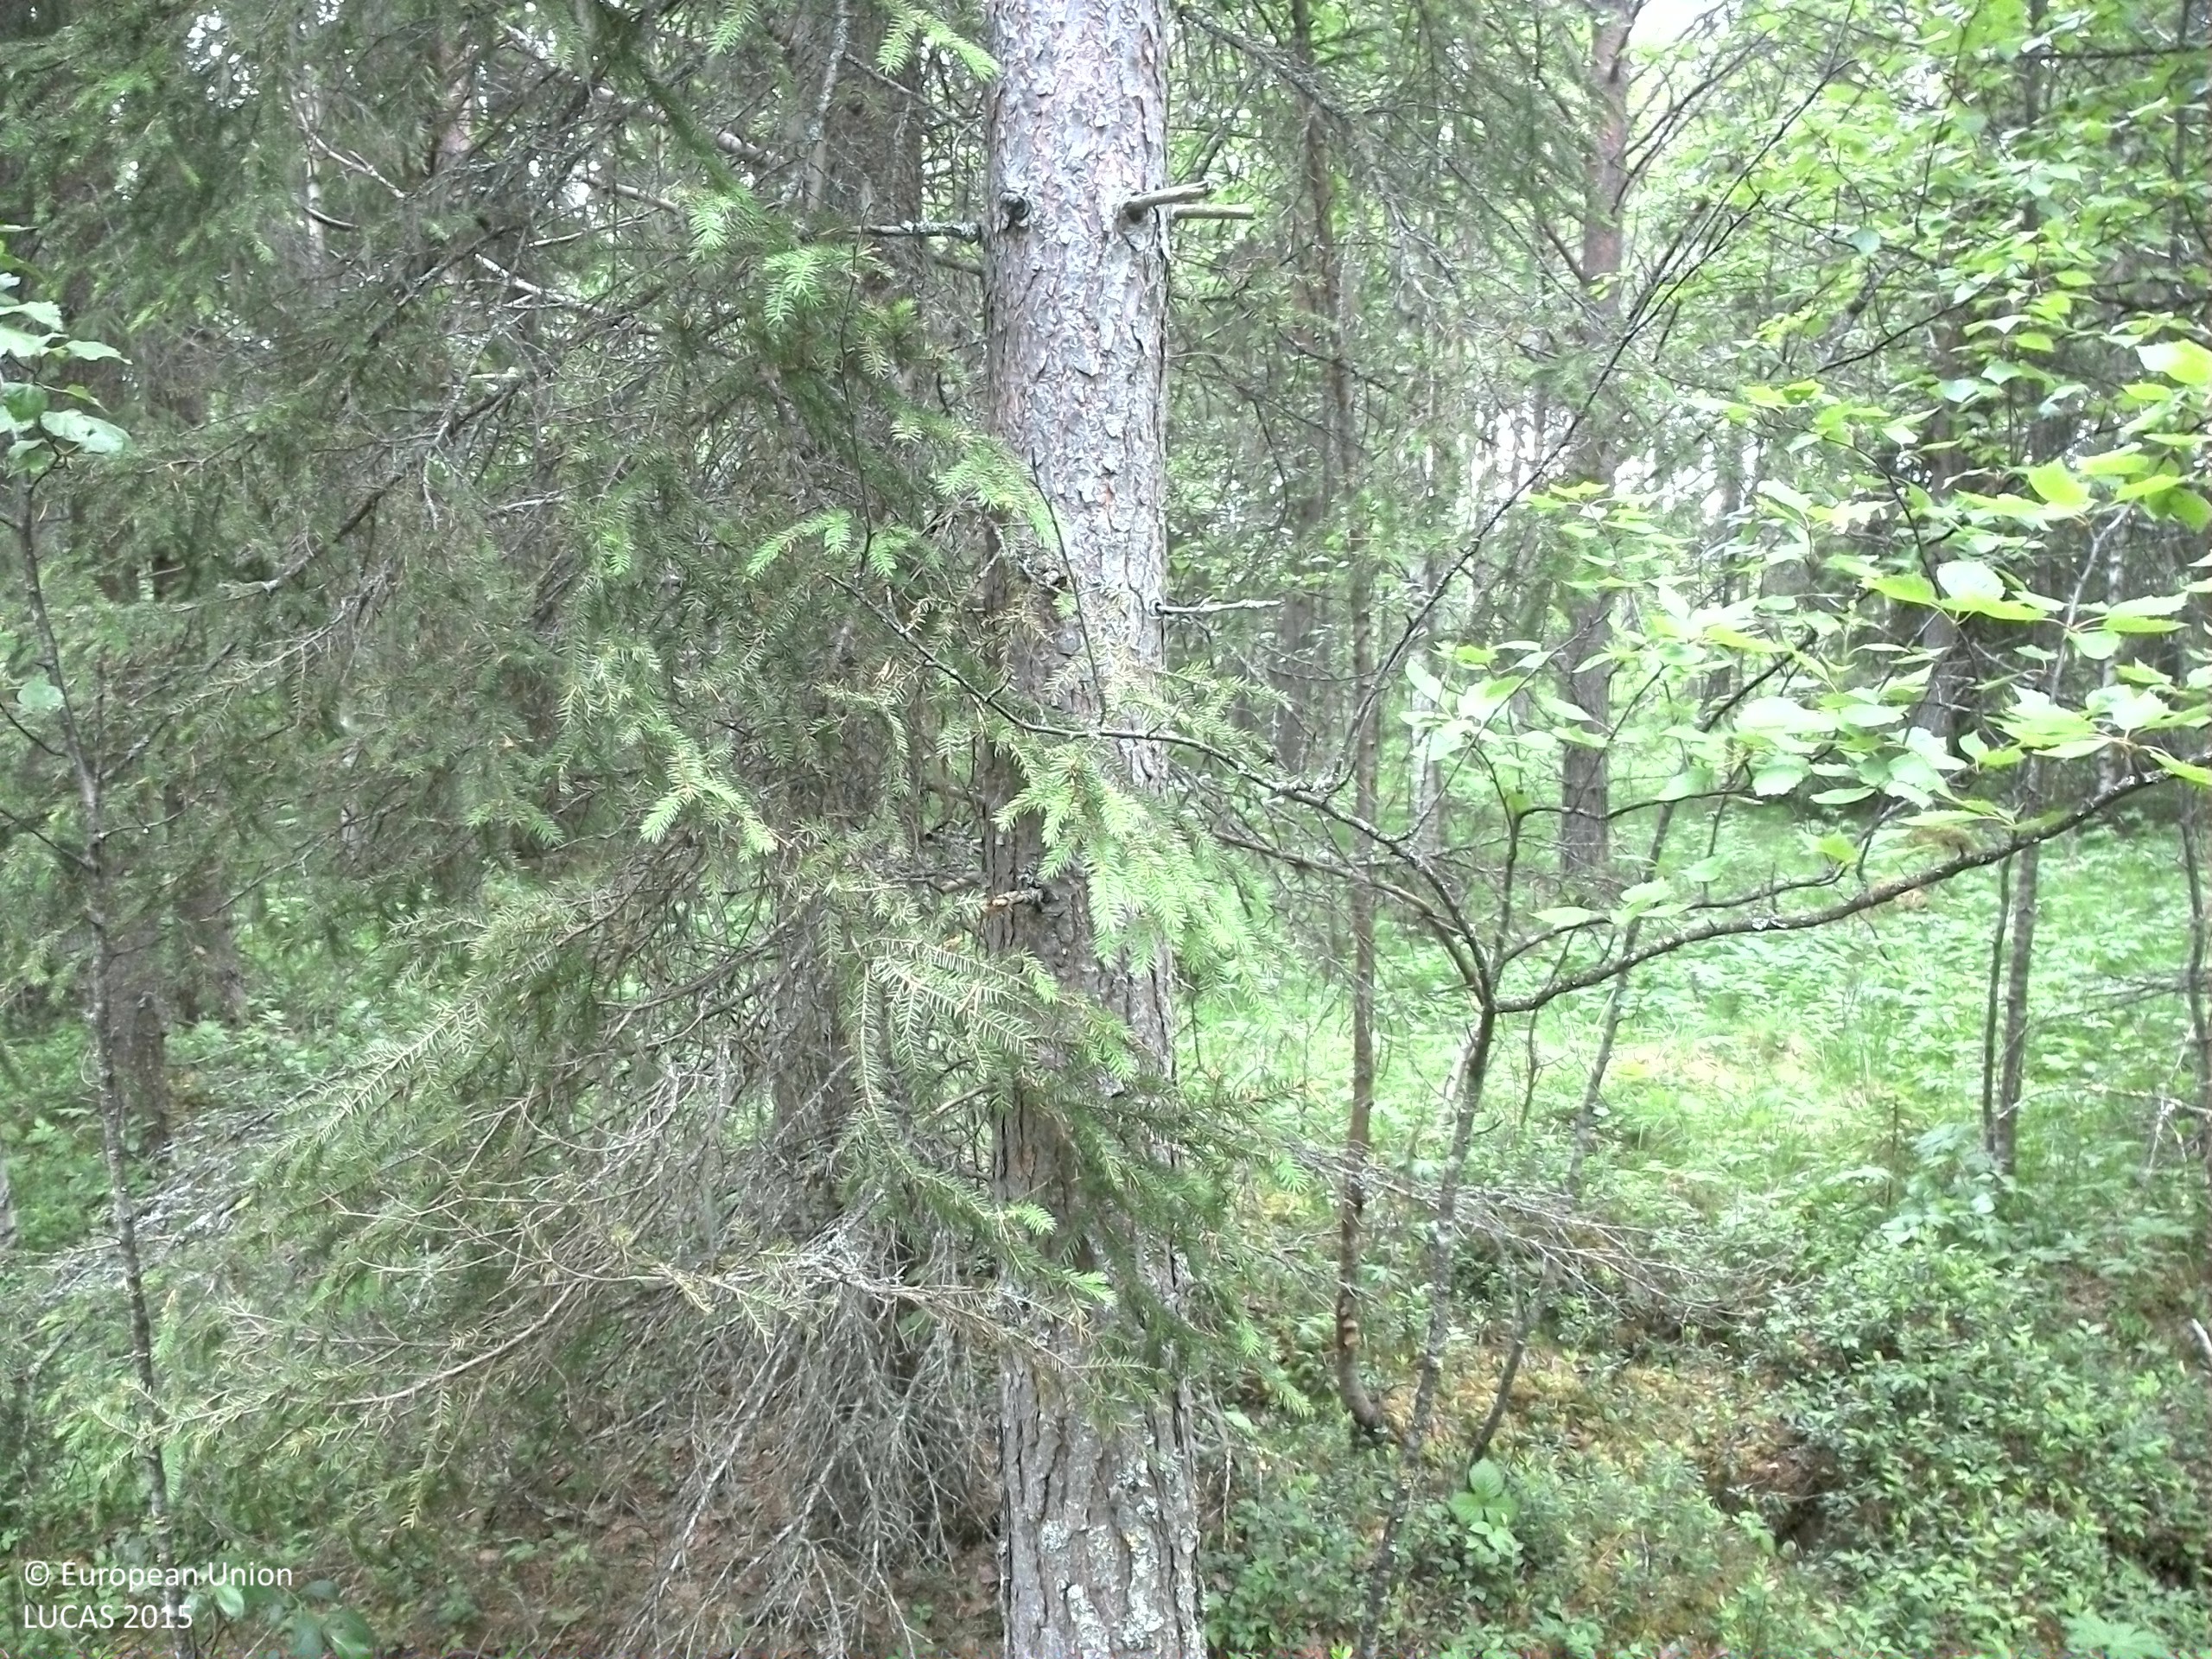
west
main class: Woodland
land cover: Other mixed woodland
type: boreal forest
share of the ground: 50 - 75 %
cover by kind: coniferous forest trees 45 %, shrubs 25 %, broadleaved forest trees 15 %, lichens and mosses 10 %, herbaceous plants 5 %
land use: Forestry
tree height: > 5 m
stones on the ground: 10 - 25 %
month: July
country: SE
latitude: 64.4096
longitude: 16.0490
